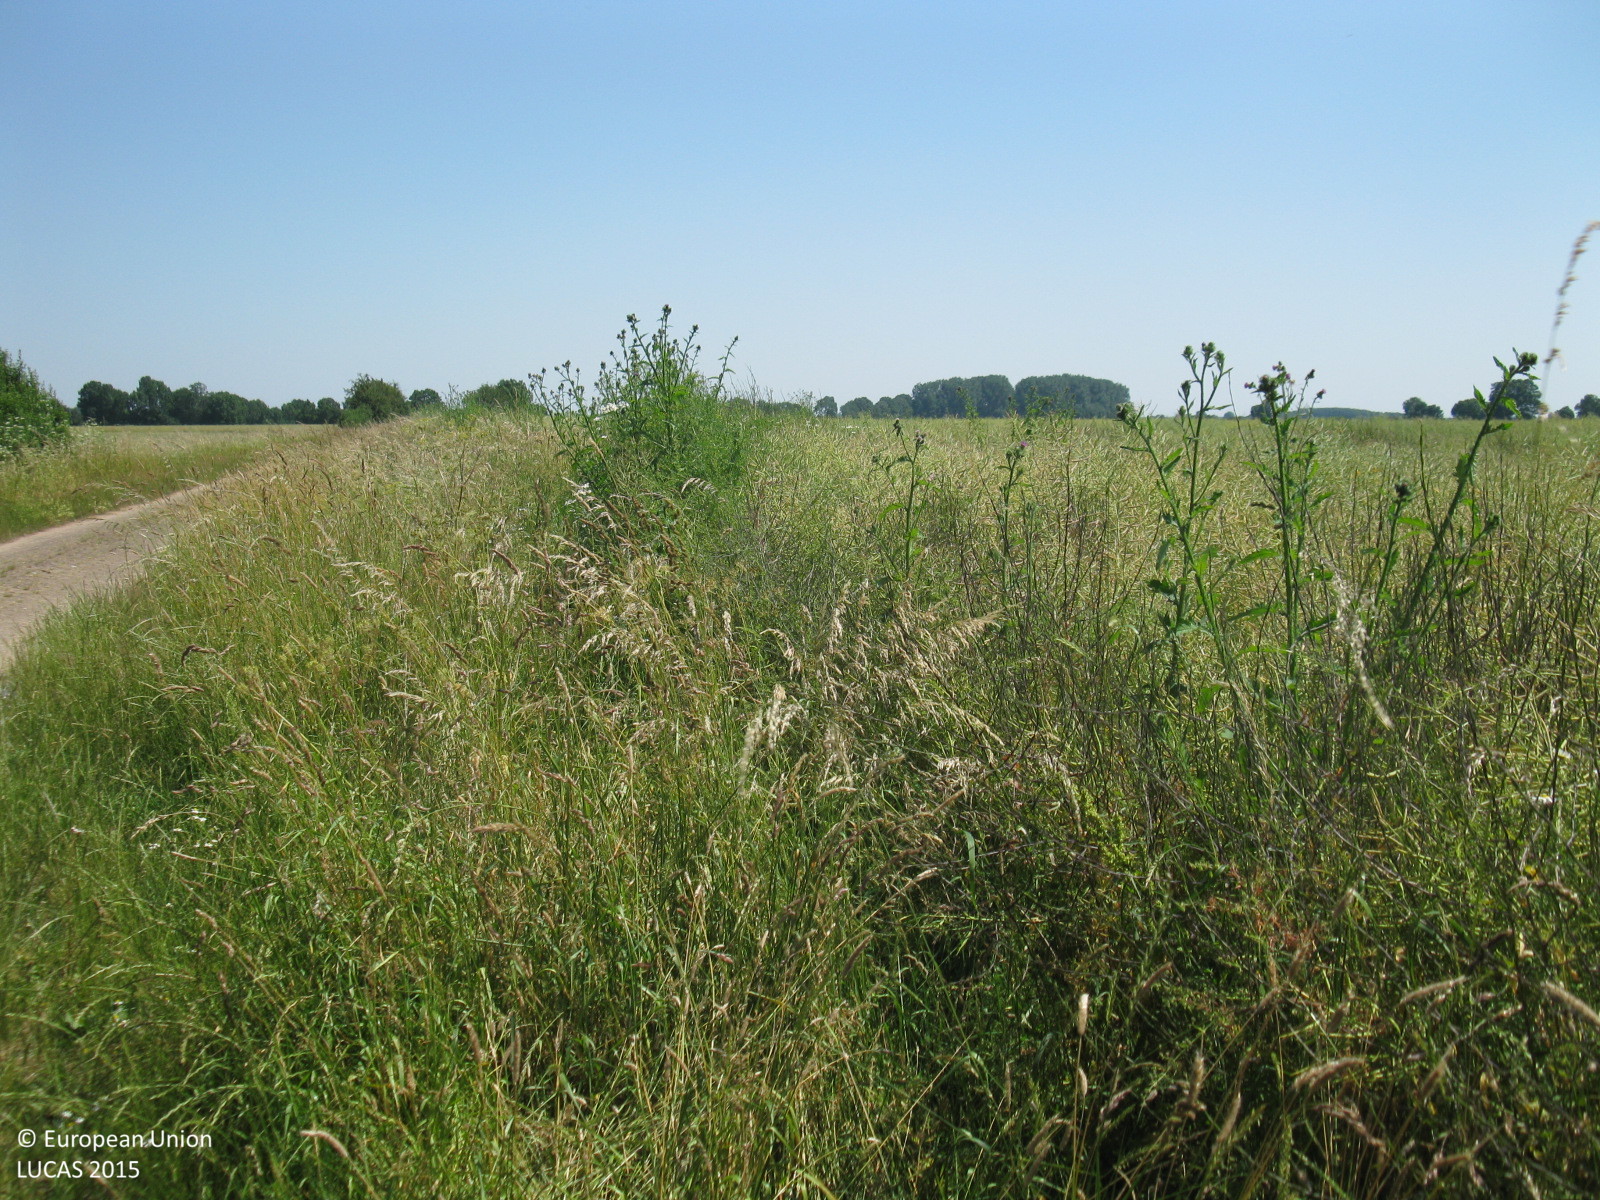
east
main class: Cropland
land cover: Rape and turnip rape
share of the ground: > 75 %
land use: Agriculture (excluding fallow land and kitchen gardens)
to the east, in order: Rape and turnip rape; Common wheat
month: July
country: DE
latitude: 52.8779
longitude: 9.1831
